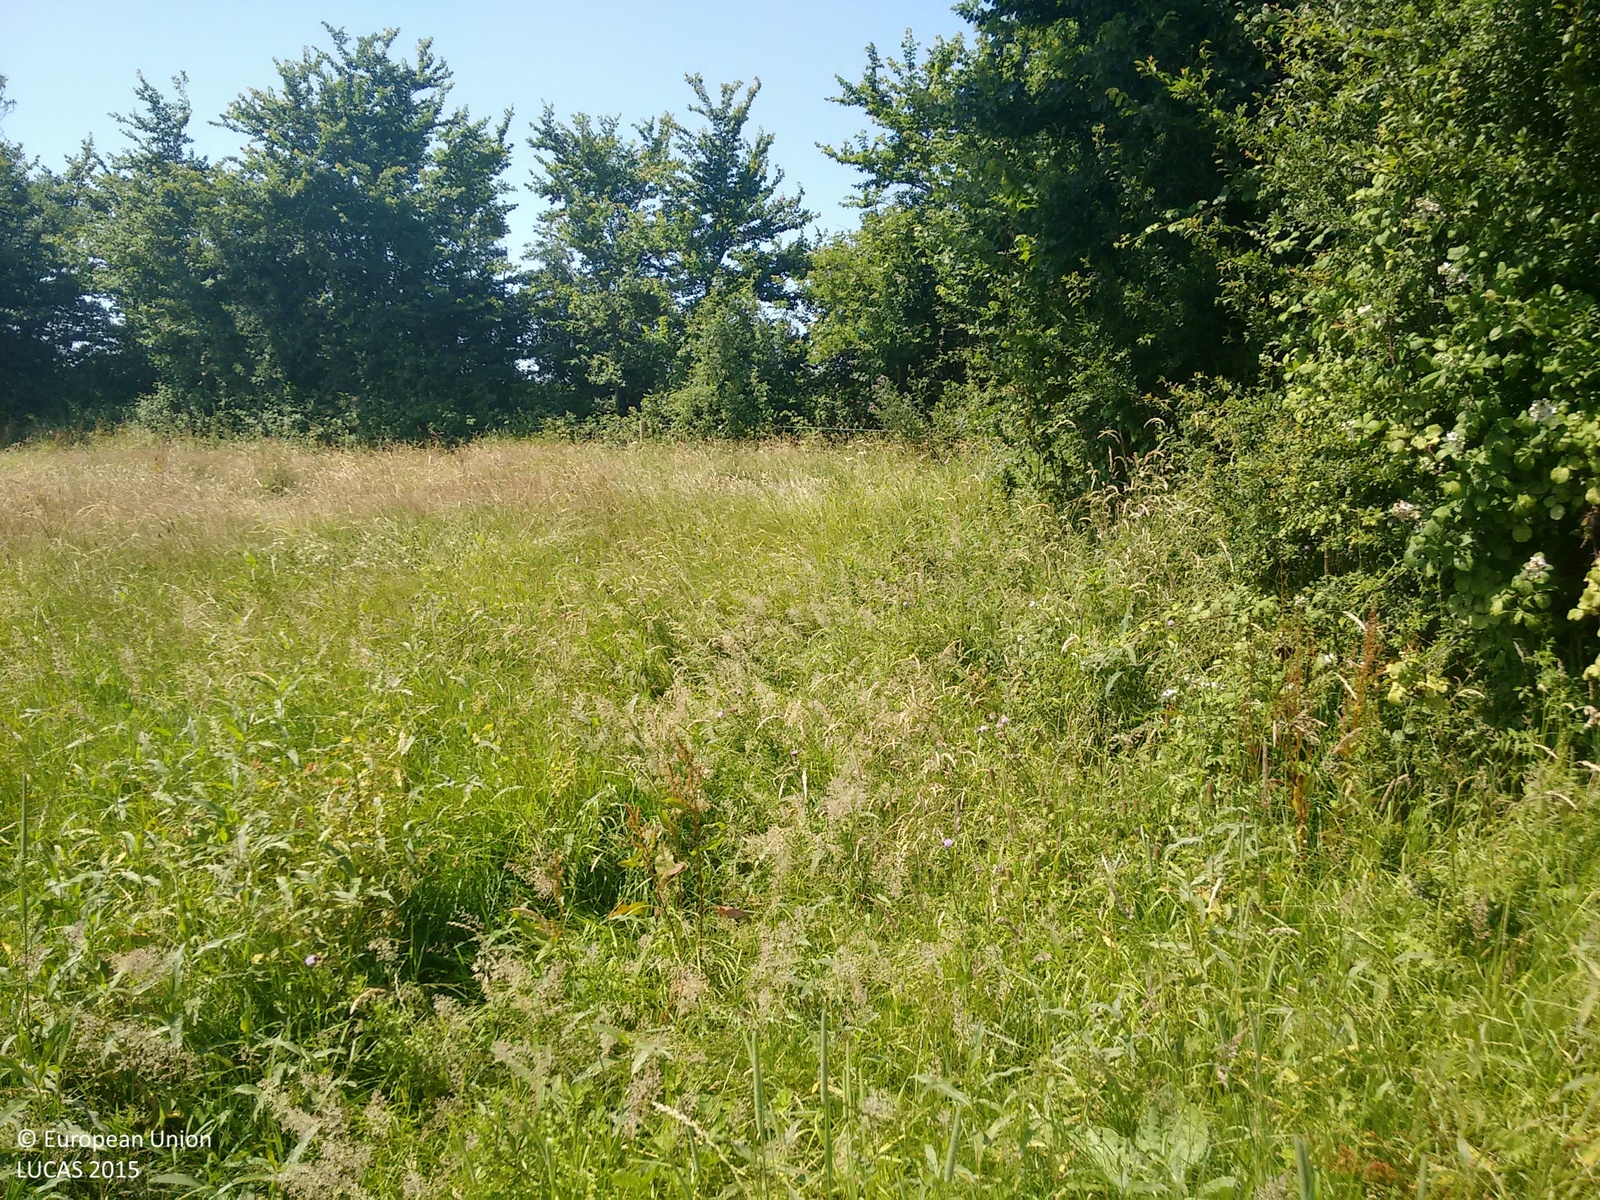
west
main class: Grassland
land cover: Grassland without tree/shrub cover
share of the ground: > 75 %
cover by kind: herbaceous plants 100 %
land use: Agriculture (excluding fallow land and kitchen gardens)
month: July
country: GB
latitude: 51.2658
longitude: -2.9295
